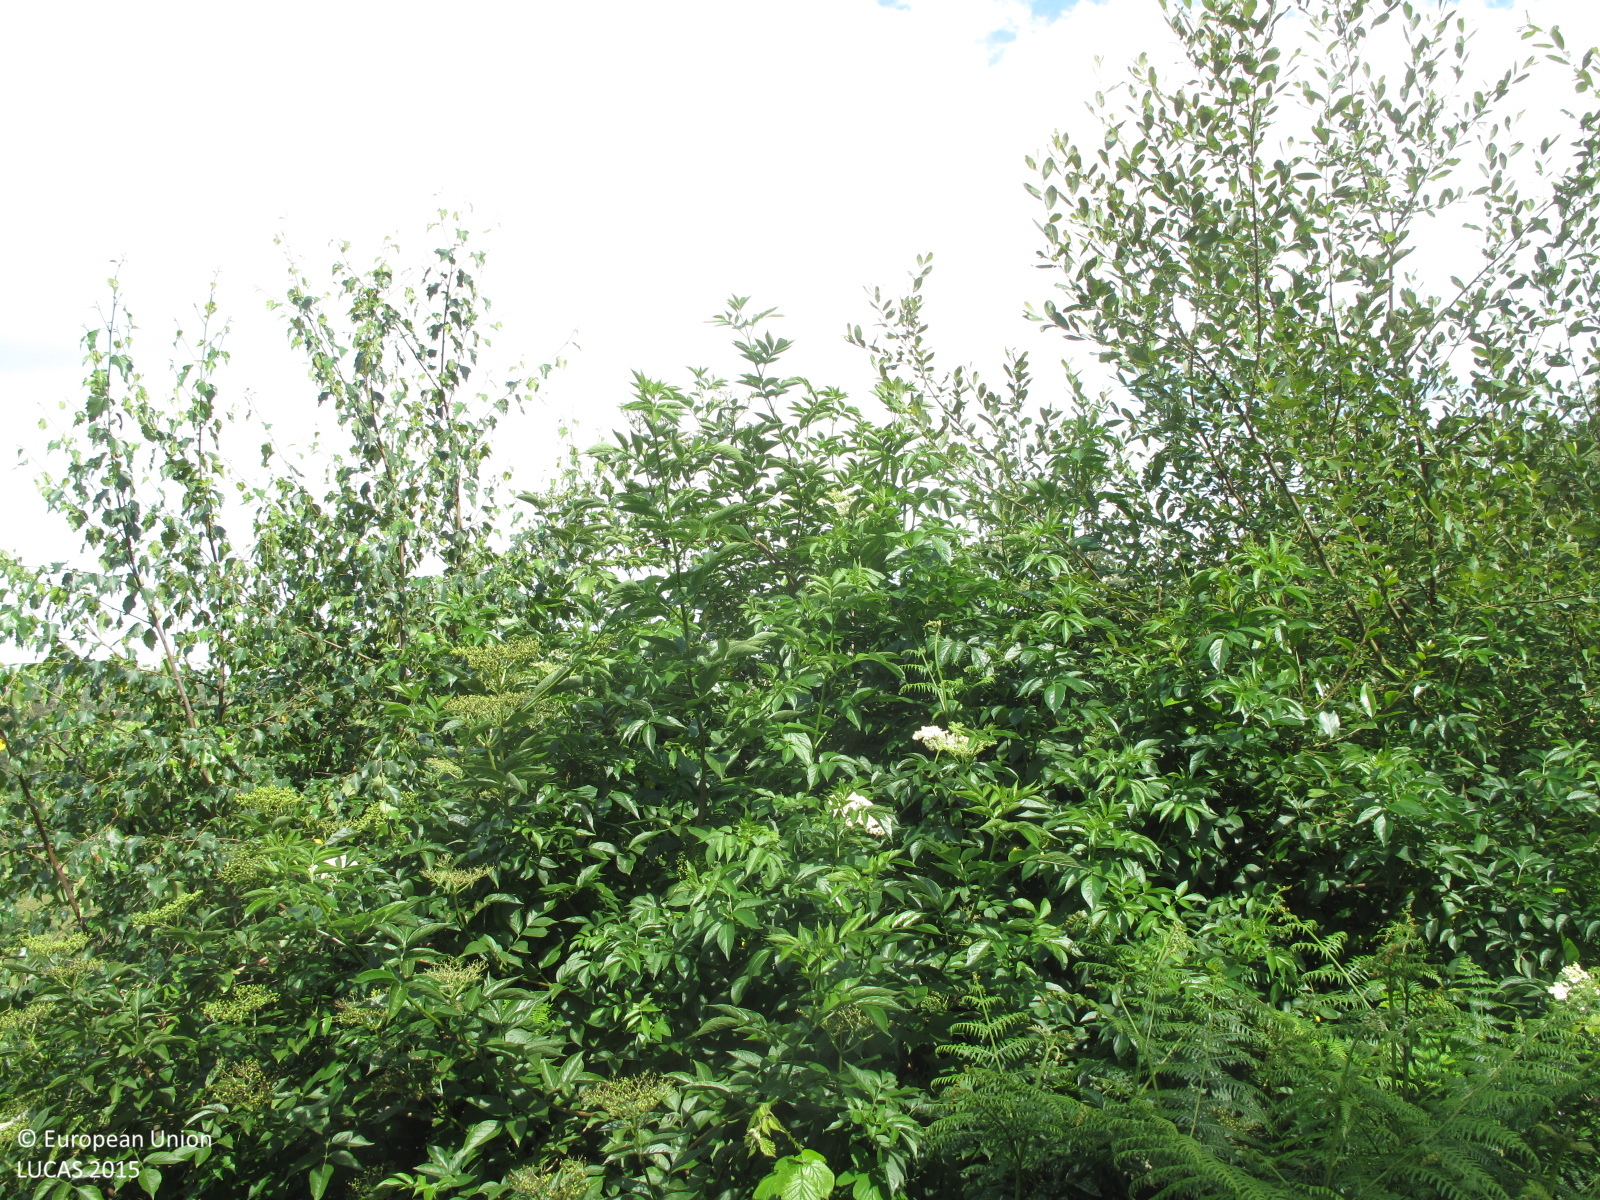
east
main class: Grassland
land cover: Grassland with sparse tree/shrub cover
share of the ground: > 75 %
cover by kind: herbaceous plants 90 %, broadleaved forest trees 5 %, shrubs 5 %
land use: Abandoned areas
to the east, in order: Grassland with sparse tree/shrub cover; Tracks; Grassland without tree/shrub cover; Spontaneously vegetated surfaces; Broadleaved woodland; Grassland without tree/shrub cover; Shrubland with sparse tree cover; Grassland without tree/shrub cover; Broadleaved woodland; Shrubland with sparse tree cover; Broadleaved woodland
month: July
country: ES
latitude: 43.2163
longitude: -8.5371
